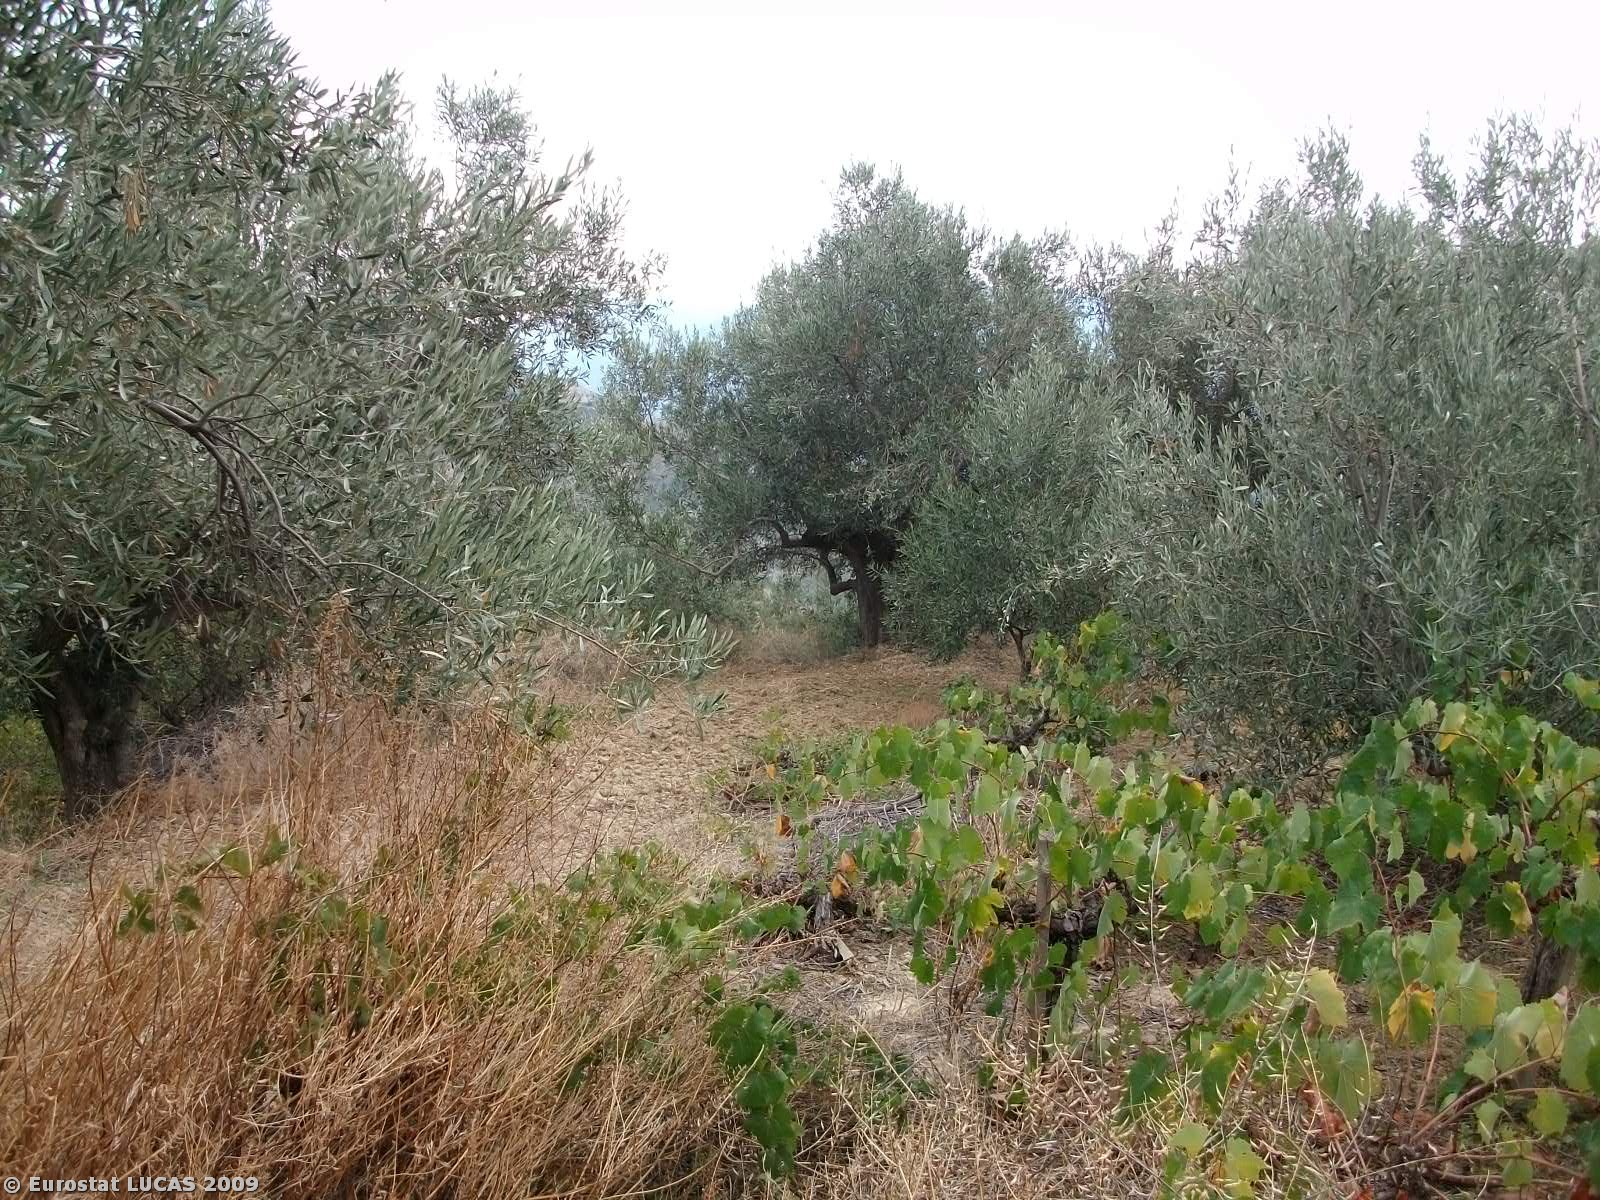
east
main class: Cropland
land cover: Olive groves
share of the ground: 50 - 75 %
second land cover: Vineyards
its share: < 10 %
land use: Agriculture (excluding fallow land and kitchen gardens)
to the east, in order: Olive groves; Vineyards; Grassland with sparse tree/shrub cover; Broadleaved woodland; Grassland with sparse tree/shrub cover; Broadleaved woodland; Olive groves; Grassland with sparse tree/shrub cover
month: September
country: GR
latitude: 38.0172
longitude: 22.5109
